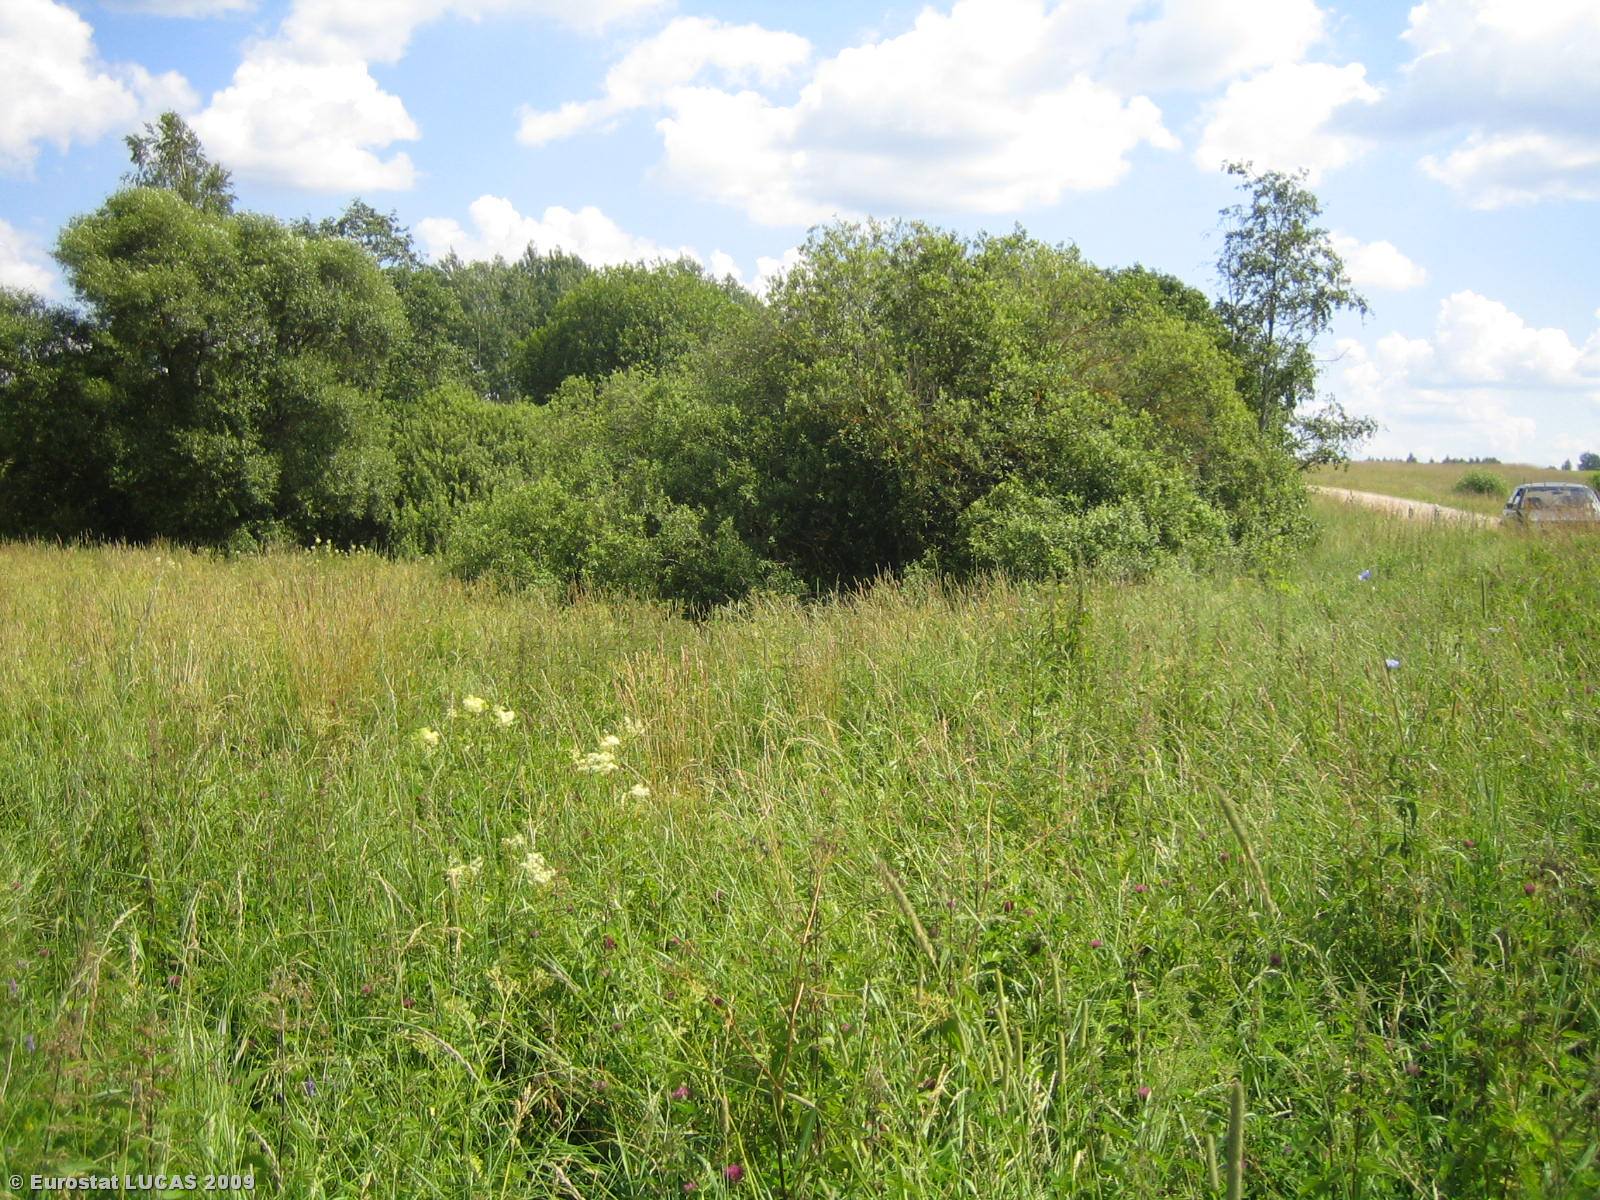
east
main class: Grassland
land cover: Grassland without tree/shrub cover
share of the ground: > 75 %
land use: Agriculture (excluding fallow land and kitchen gardens)
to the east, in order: Grassland without tree/shrub cover; Single bushes/trees; Grassland without tree/shrub cover; Broadleaved woodland; Grassland without tree/shrub cover; Grassland with sparse tree/shrub cover
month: July
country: LT
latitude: 55.7706
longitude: 25.9318
